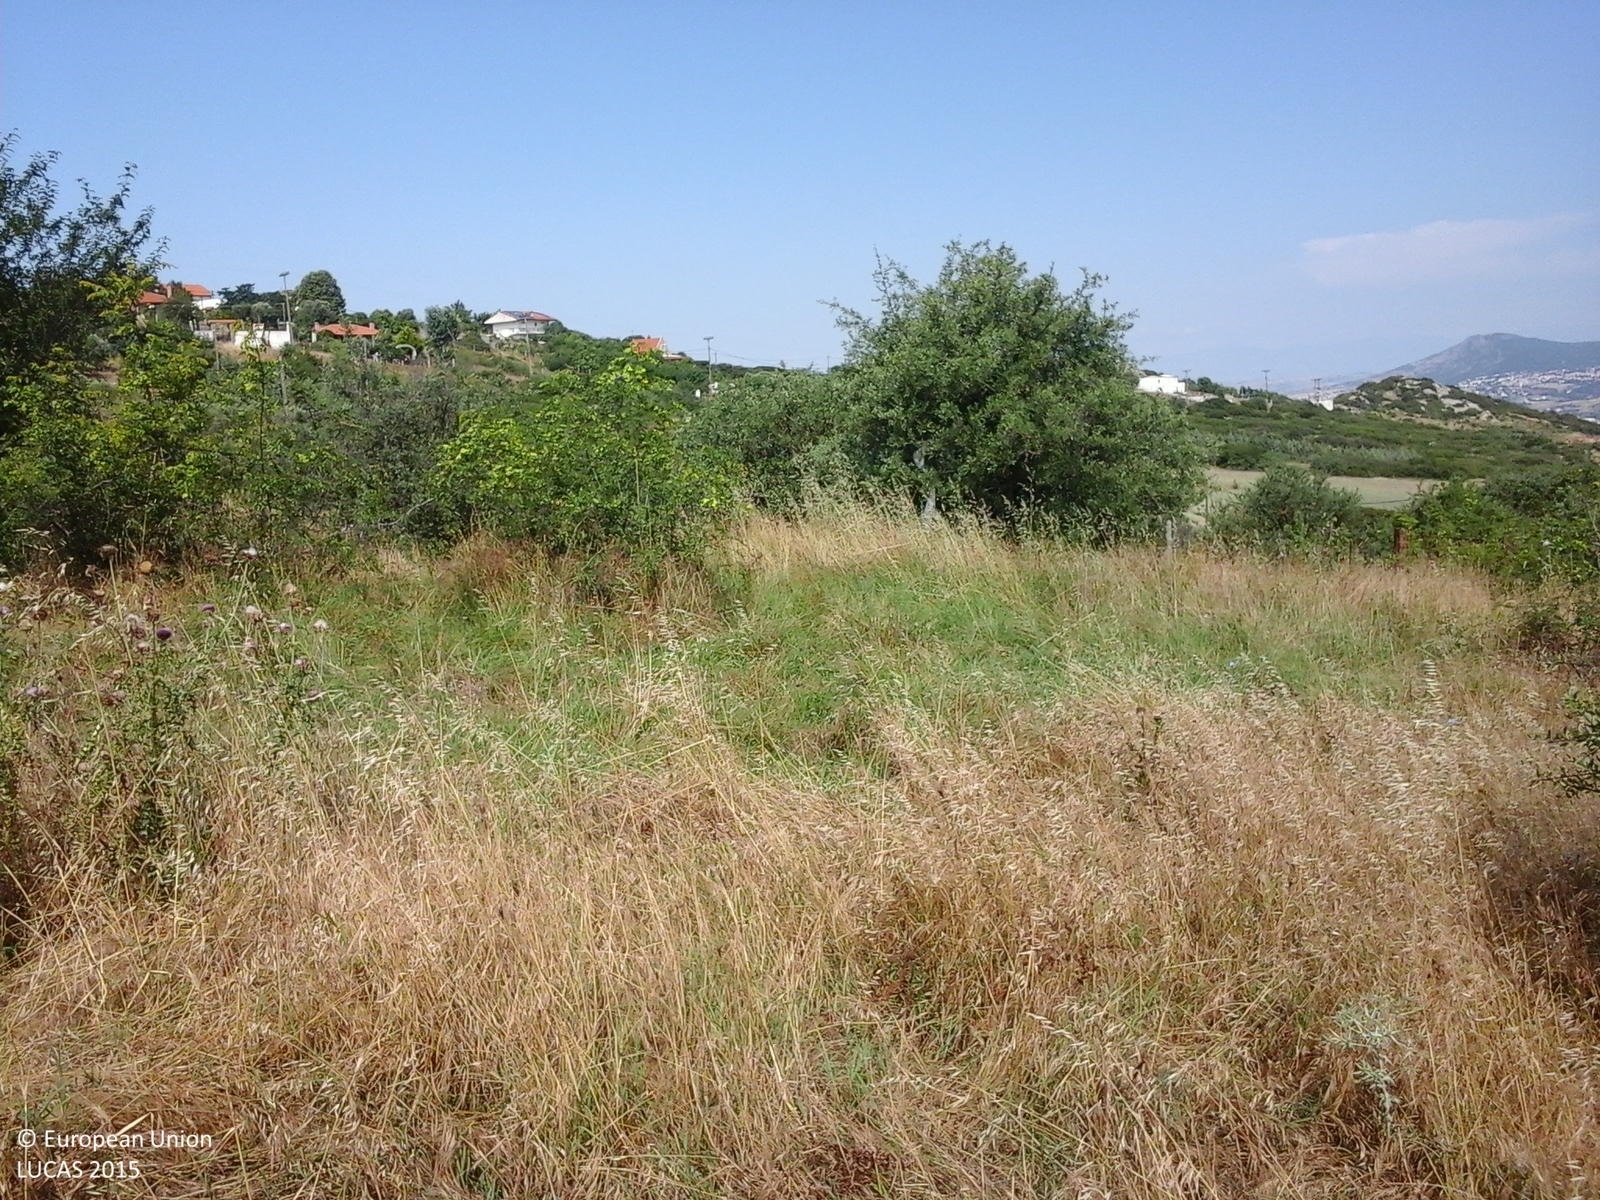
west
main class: Grassland
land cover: Spontaneously vegetated surfaces
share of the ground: > 75 %
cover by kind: herbaceous plants 100 %
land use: Semi-natural and natural areas not in use
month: June
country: GR
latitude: 40.6807
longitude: 22.9874
